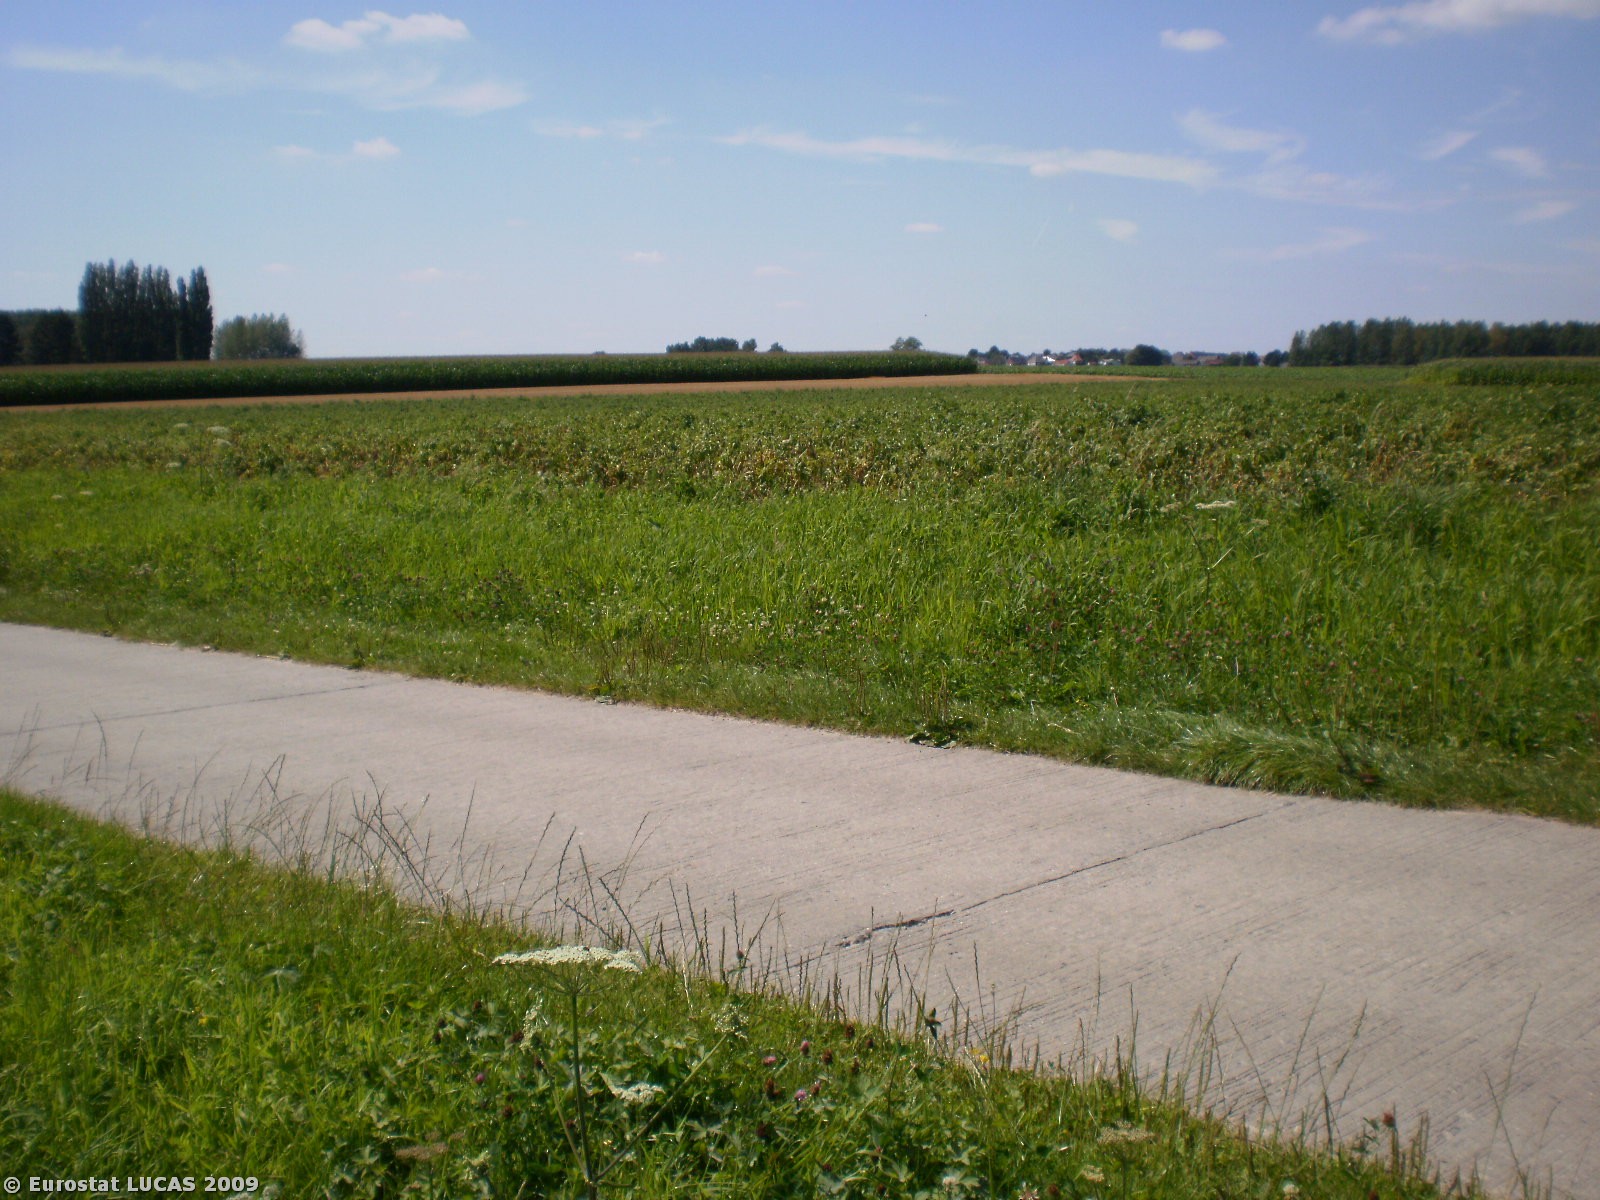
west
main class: Grassland
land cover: Grassland without tree/shrub cover
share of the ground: > 75 %
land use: Agriculture (excluding fallow land and kitchen gardens)
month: August
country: BE
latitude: 50.7907
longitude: 3.7942
